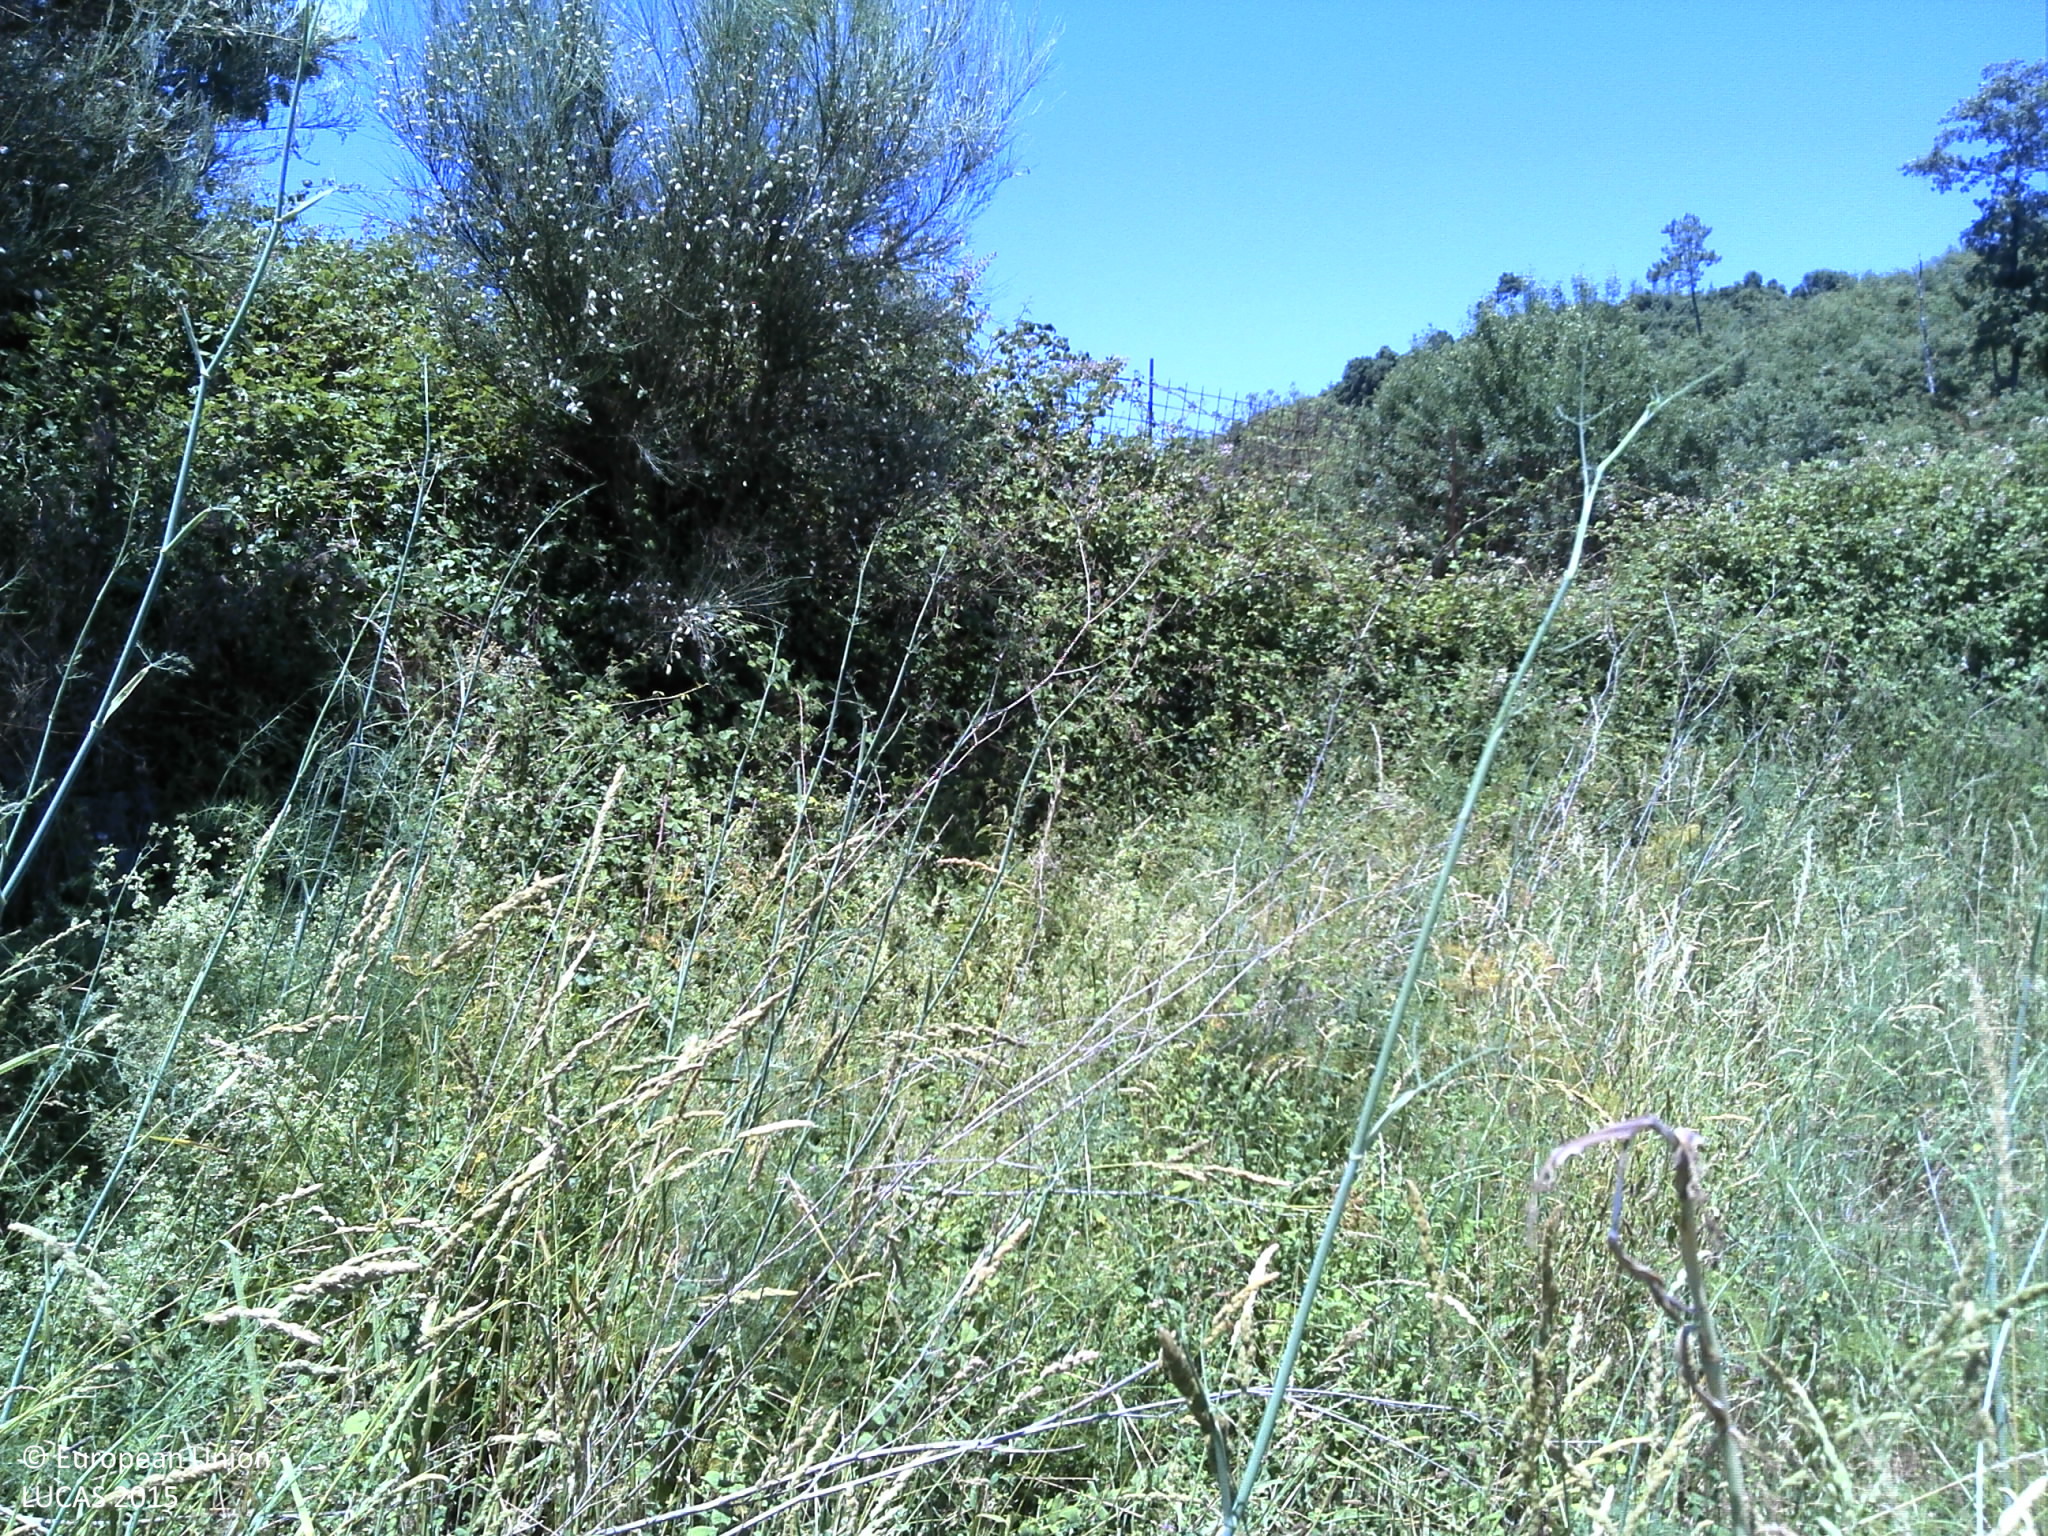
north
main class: Shrubland
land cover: Shrubland with sparse tree cover
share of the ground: > 75 %
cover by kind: shrubs 95 %, broadleaved forest trees 5 %
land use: Semi-natural and natural areas not in use
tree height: > 5 m
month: June
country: PT
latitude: 40.7432
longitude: -7.3179
